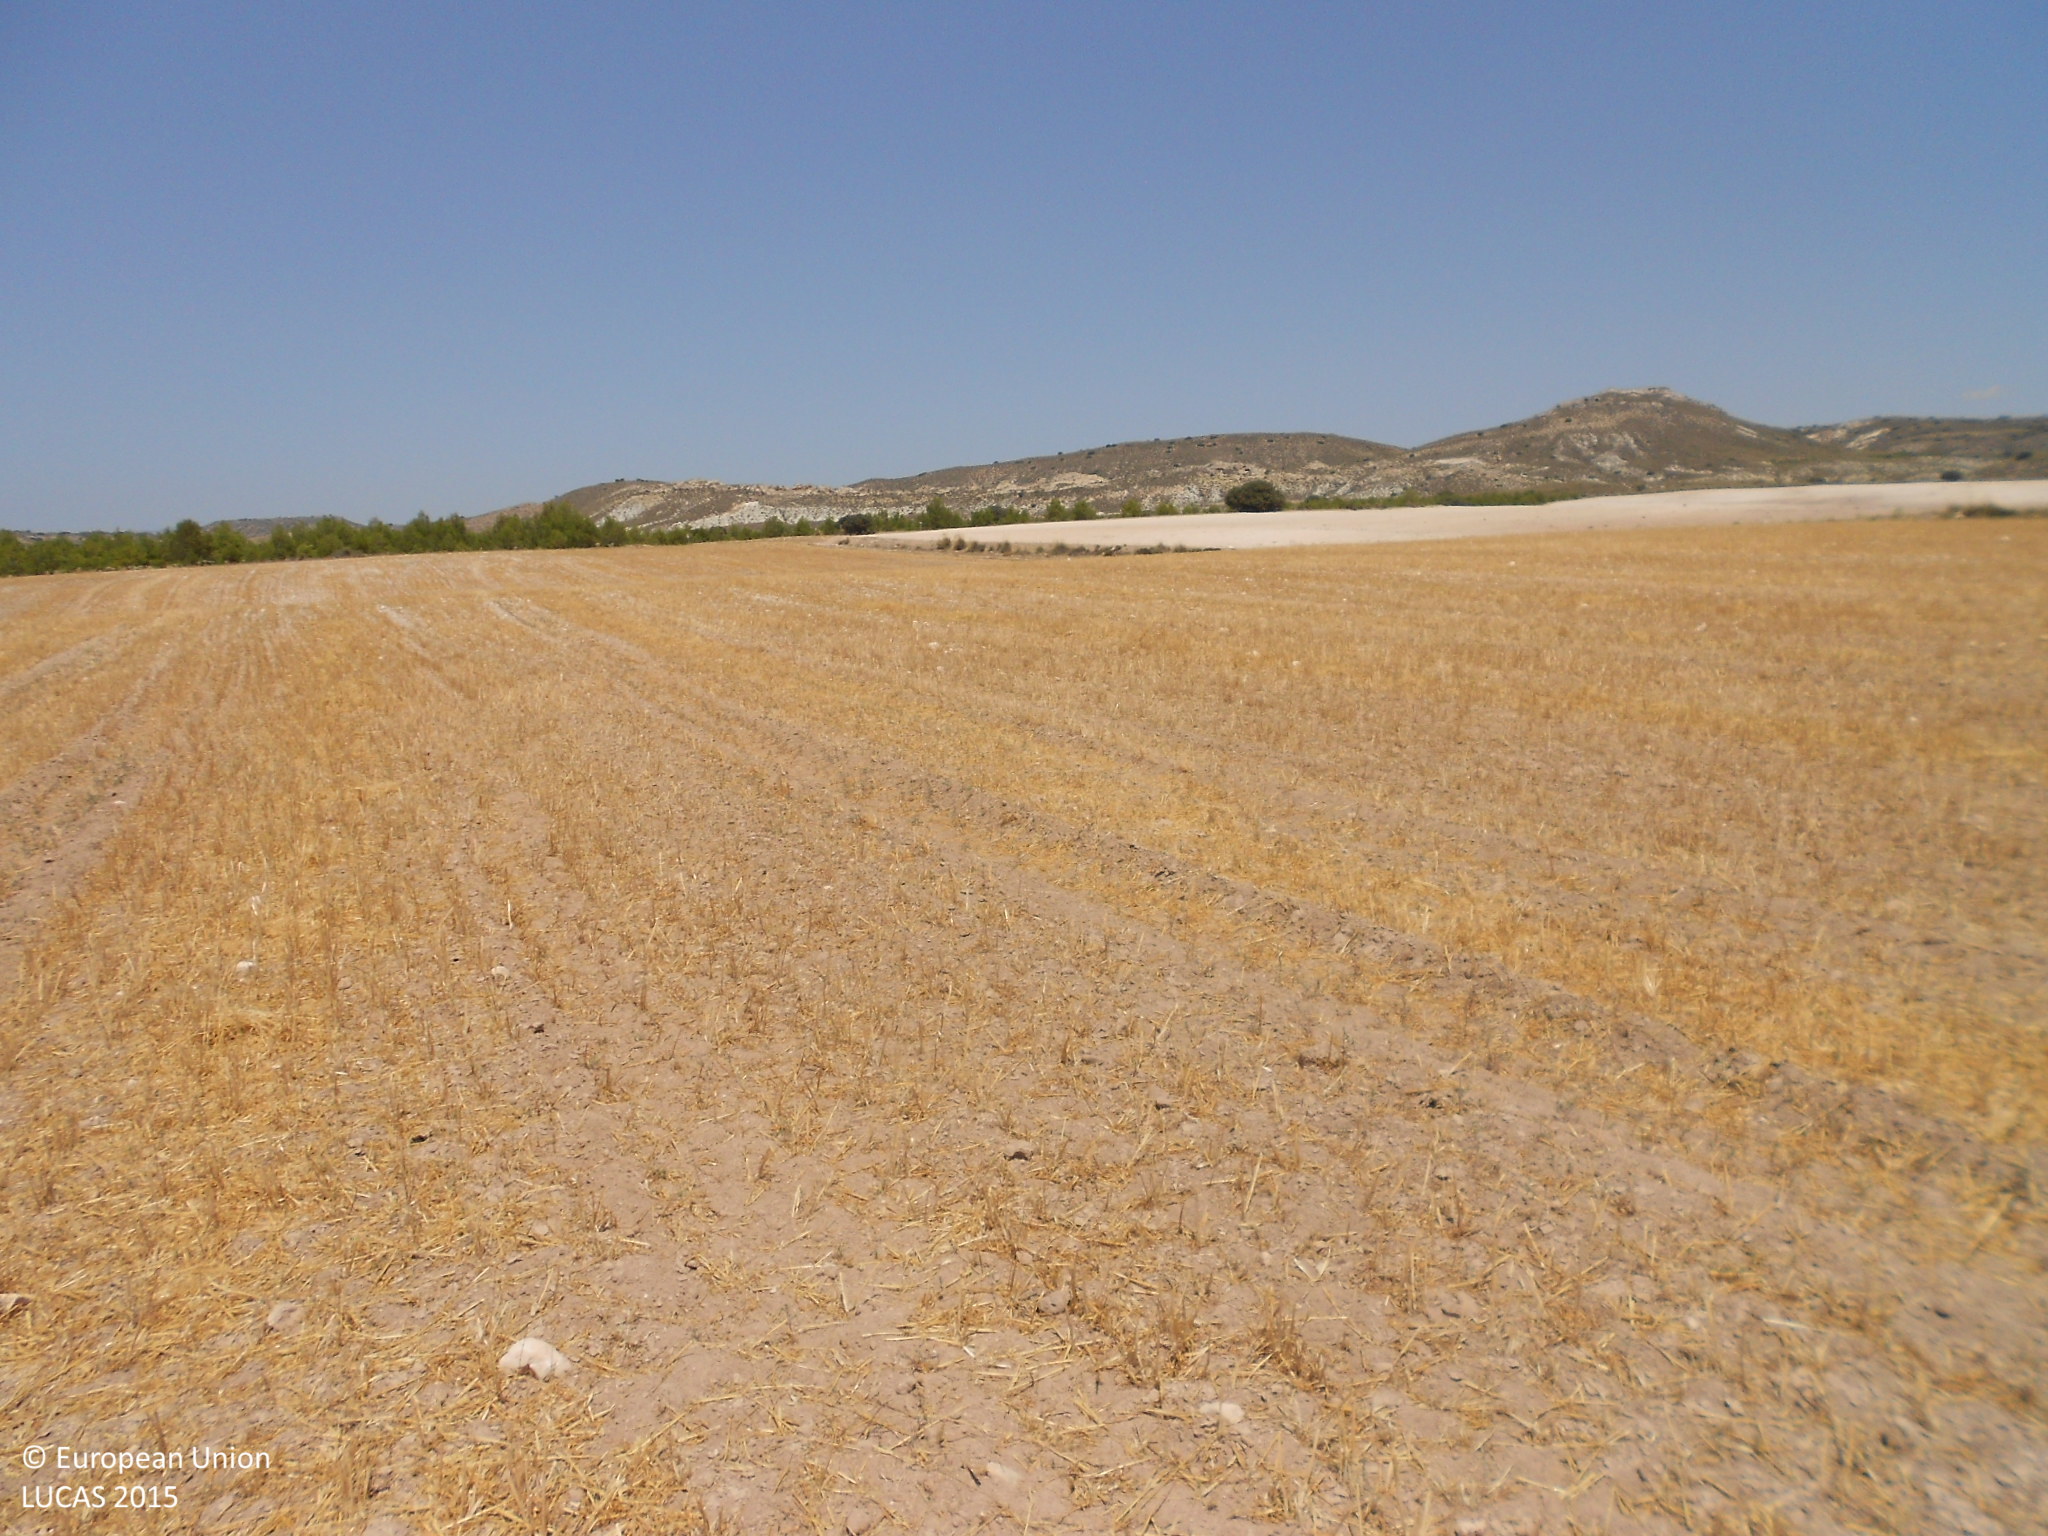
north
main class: Cropland
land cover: Oats
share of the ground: < 10 %
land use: Agriculture (excluding fallow land and kitchen gardens)
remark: Harvested field
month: August
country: ES
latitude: 37.7308
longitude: -2.3209
